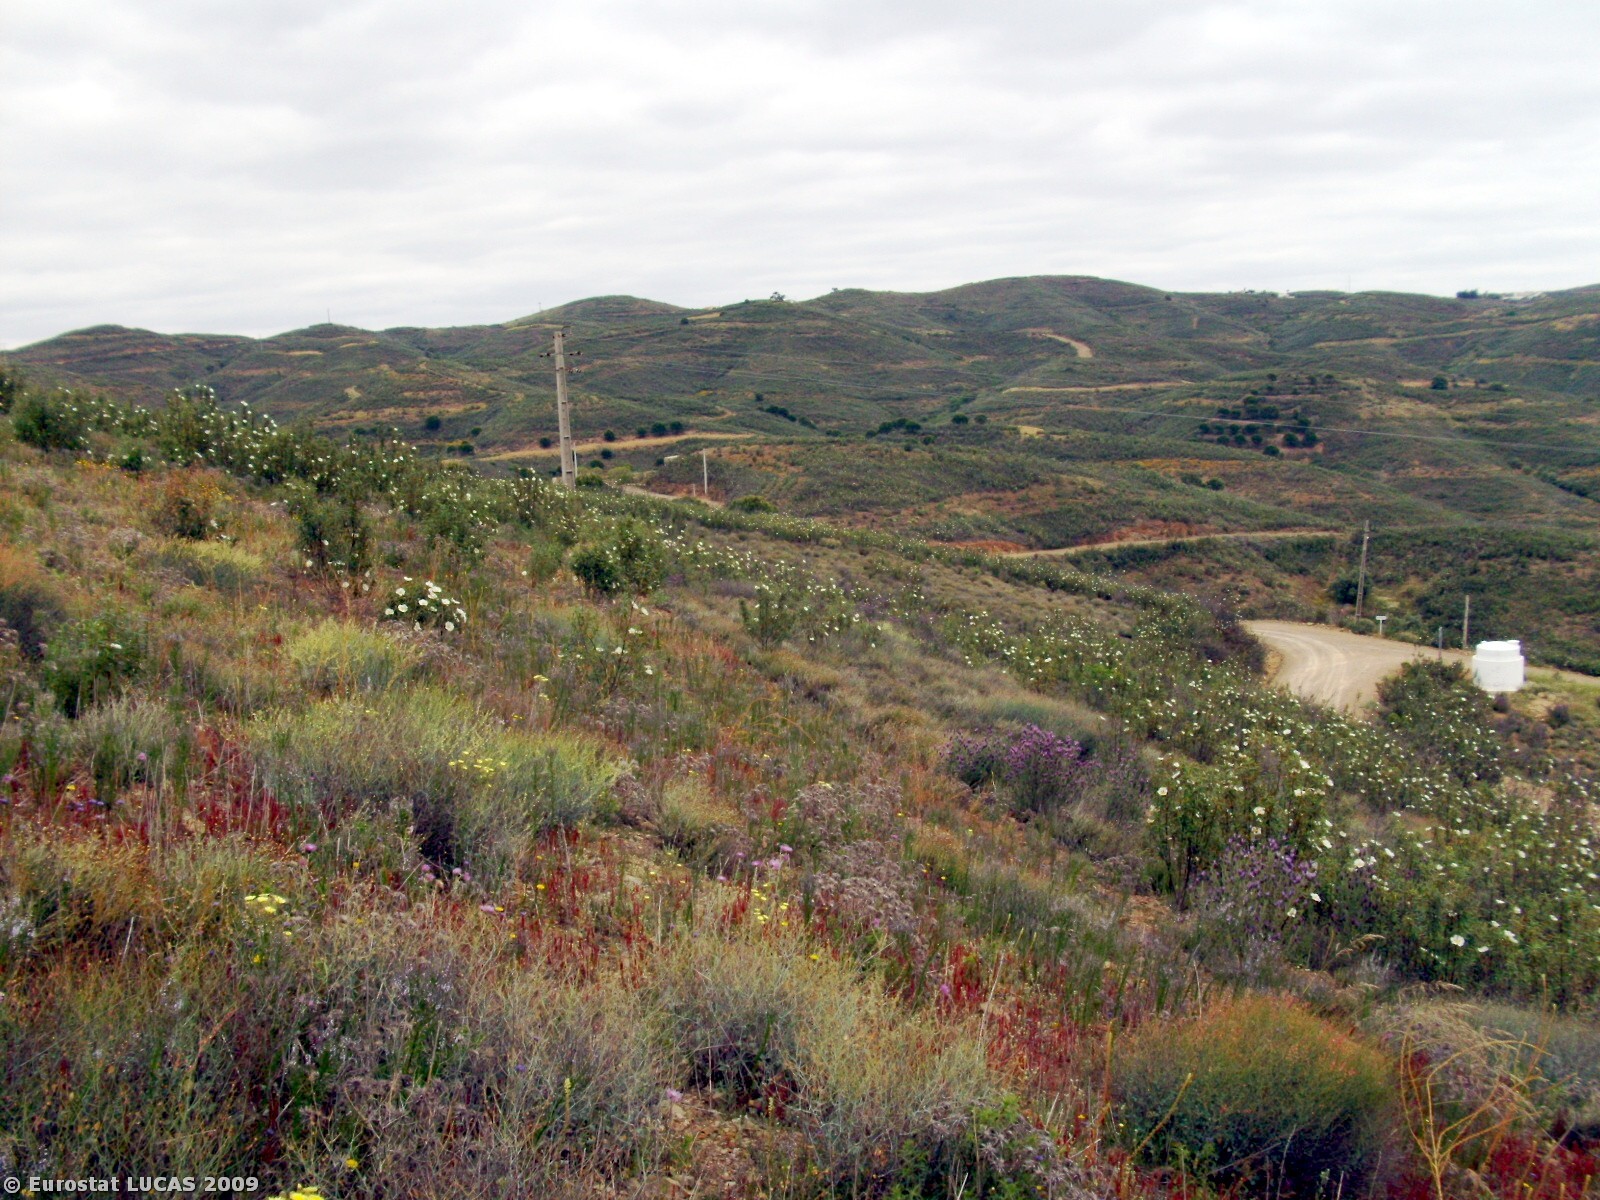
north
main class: Shrubland
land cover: Shrubland without tree cover
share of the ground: > 75 %
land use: Unused
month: April
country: PT
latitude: 37.2345
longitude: -7.6242
